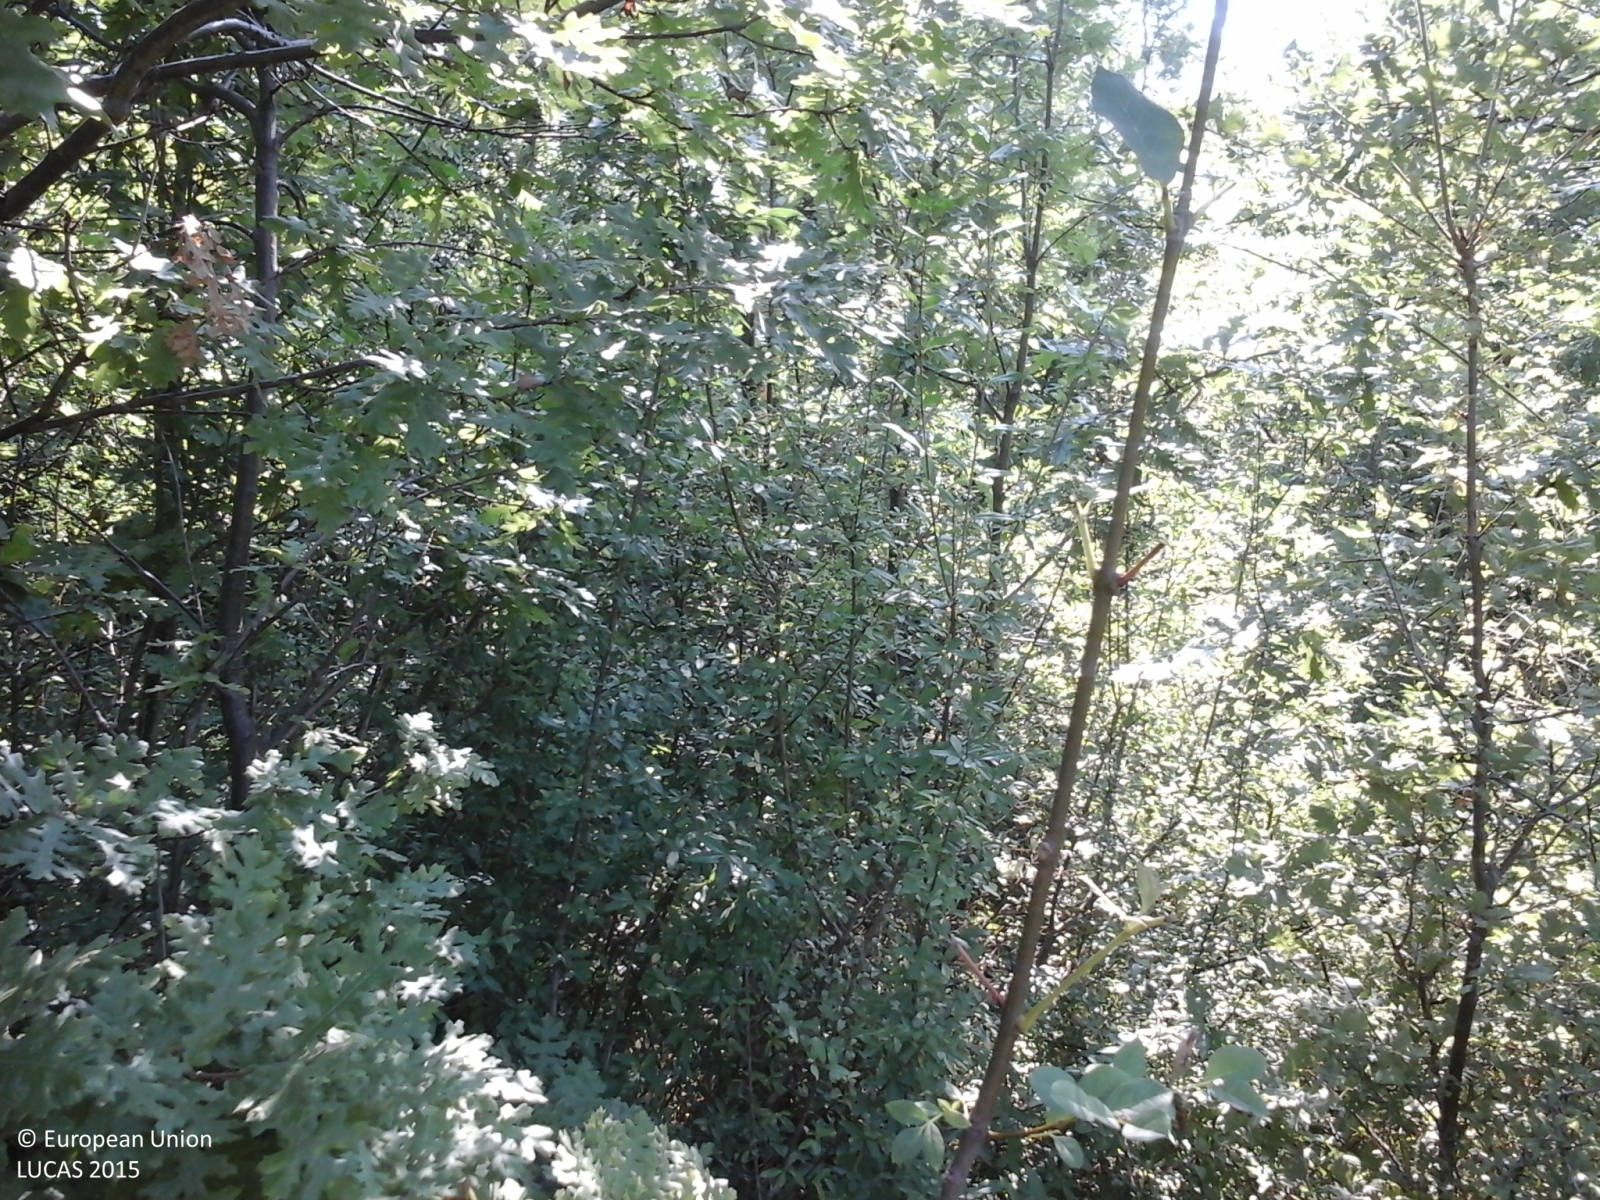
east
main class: Woodland
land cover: Broadleaved woodland
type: thermophilous deciduous forest
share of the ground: > 75 %
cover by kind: broadleaved forest trees 100 %
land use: Forestry
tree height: > 5 m
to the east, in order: Broadleaved woodland; Tracks; Broadleaved woodland
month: August
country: IT
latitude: 43.7297
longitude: 12.2910
